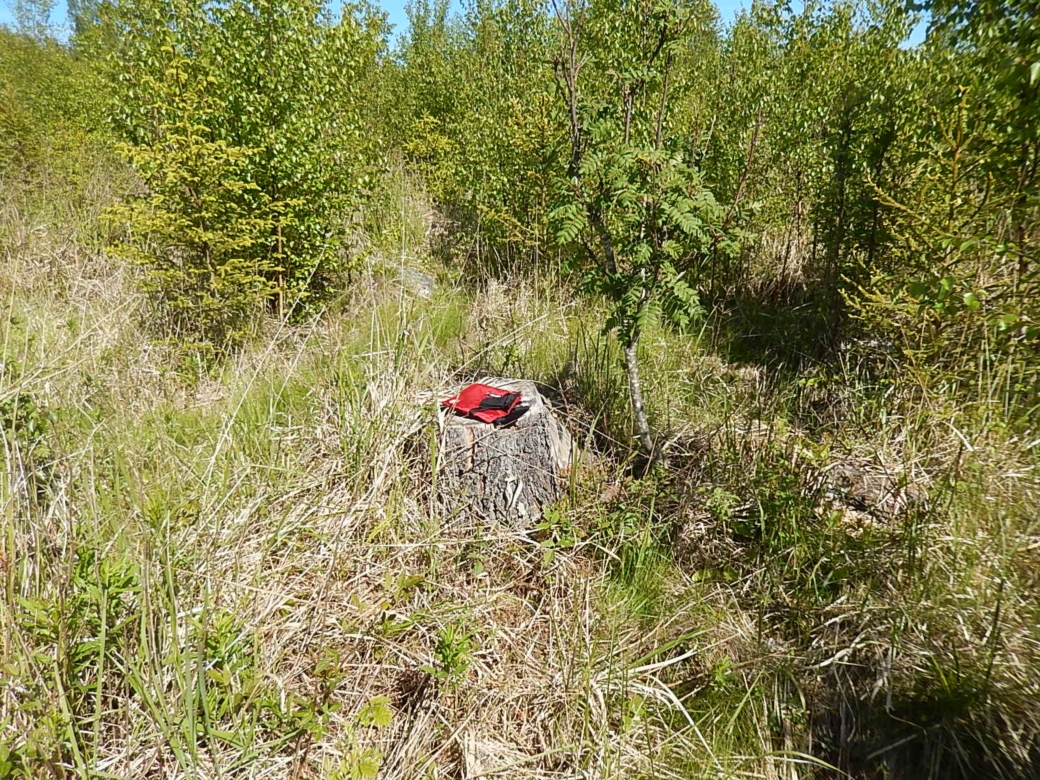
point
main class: Woodland
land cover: Other mixed woodland
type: boreal forest
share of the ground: 50 - 75 %
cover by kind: broadleaved forest trees 45 %, herbaceous plants 30 %, coniferous forest trees 25 %
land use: Forestry
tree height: < 5 m
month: June
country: FI
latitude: 62.0100
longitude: 21.4491
